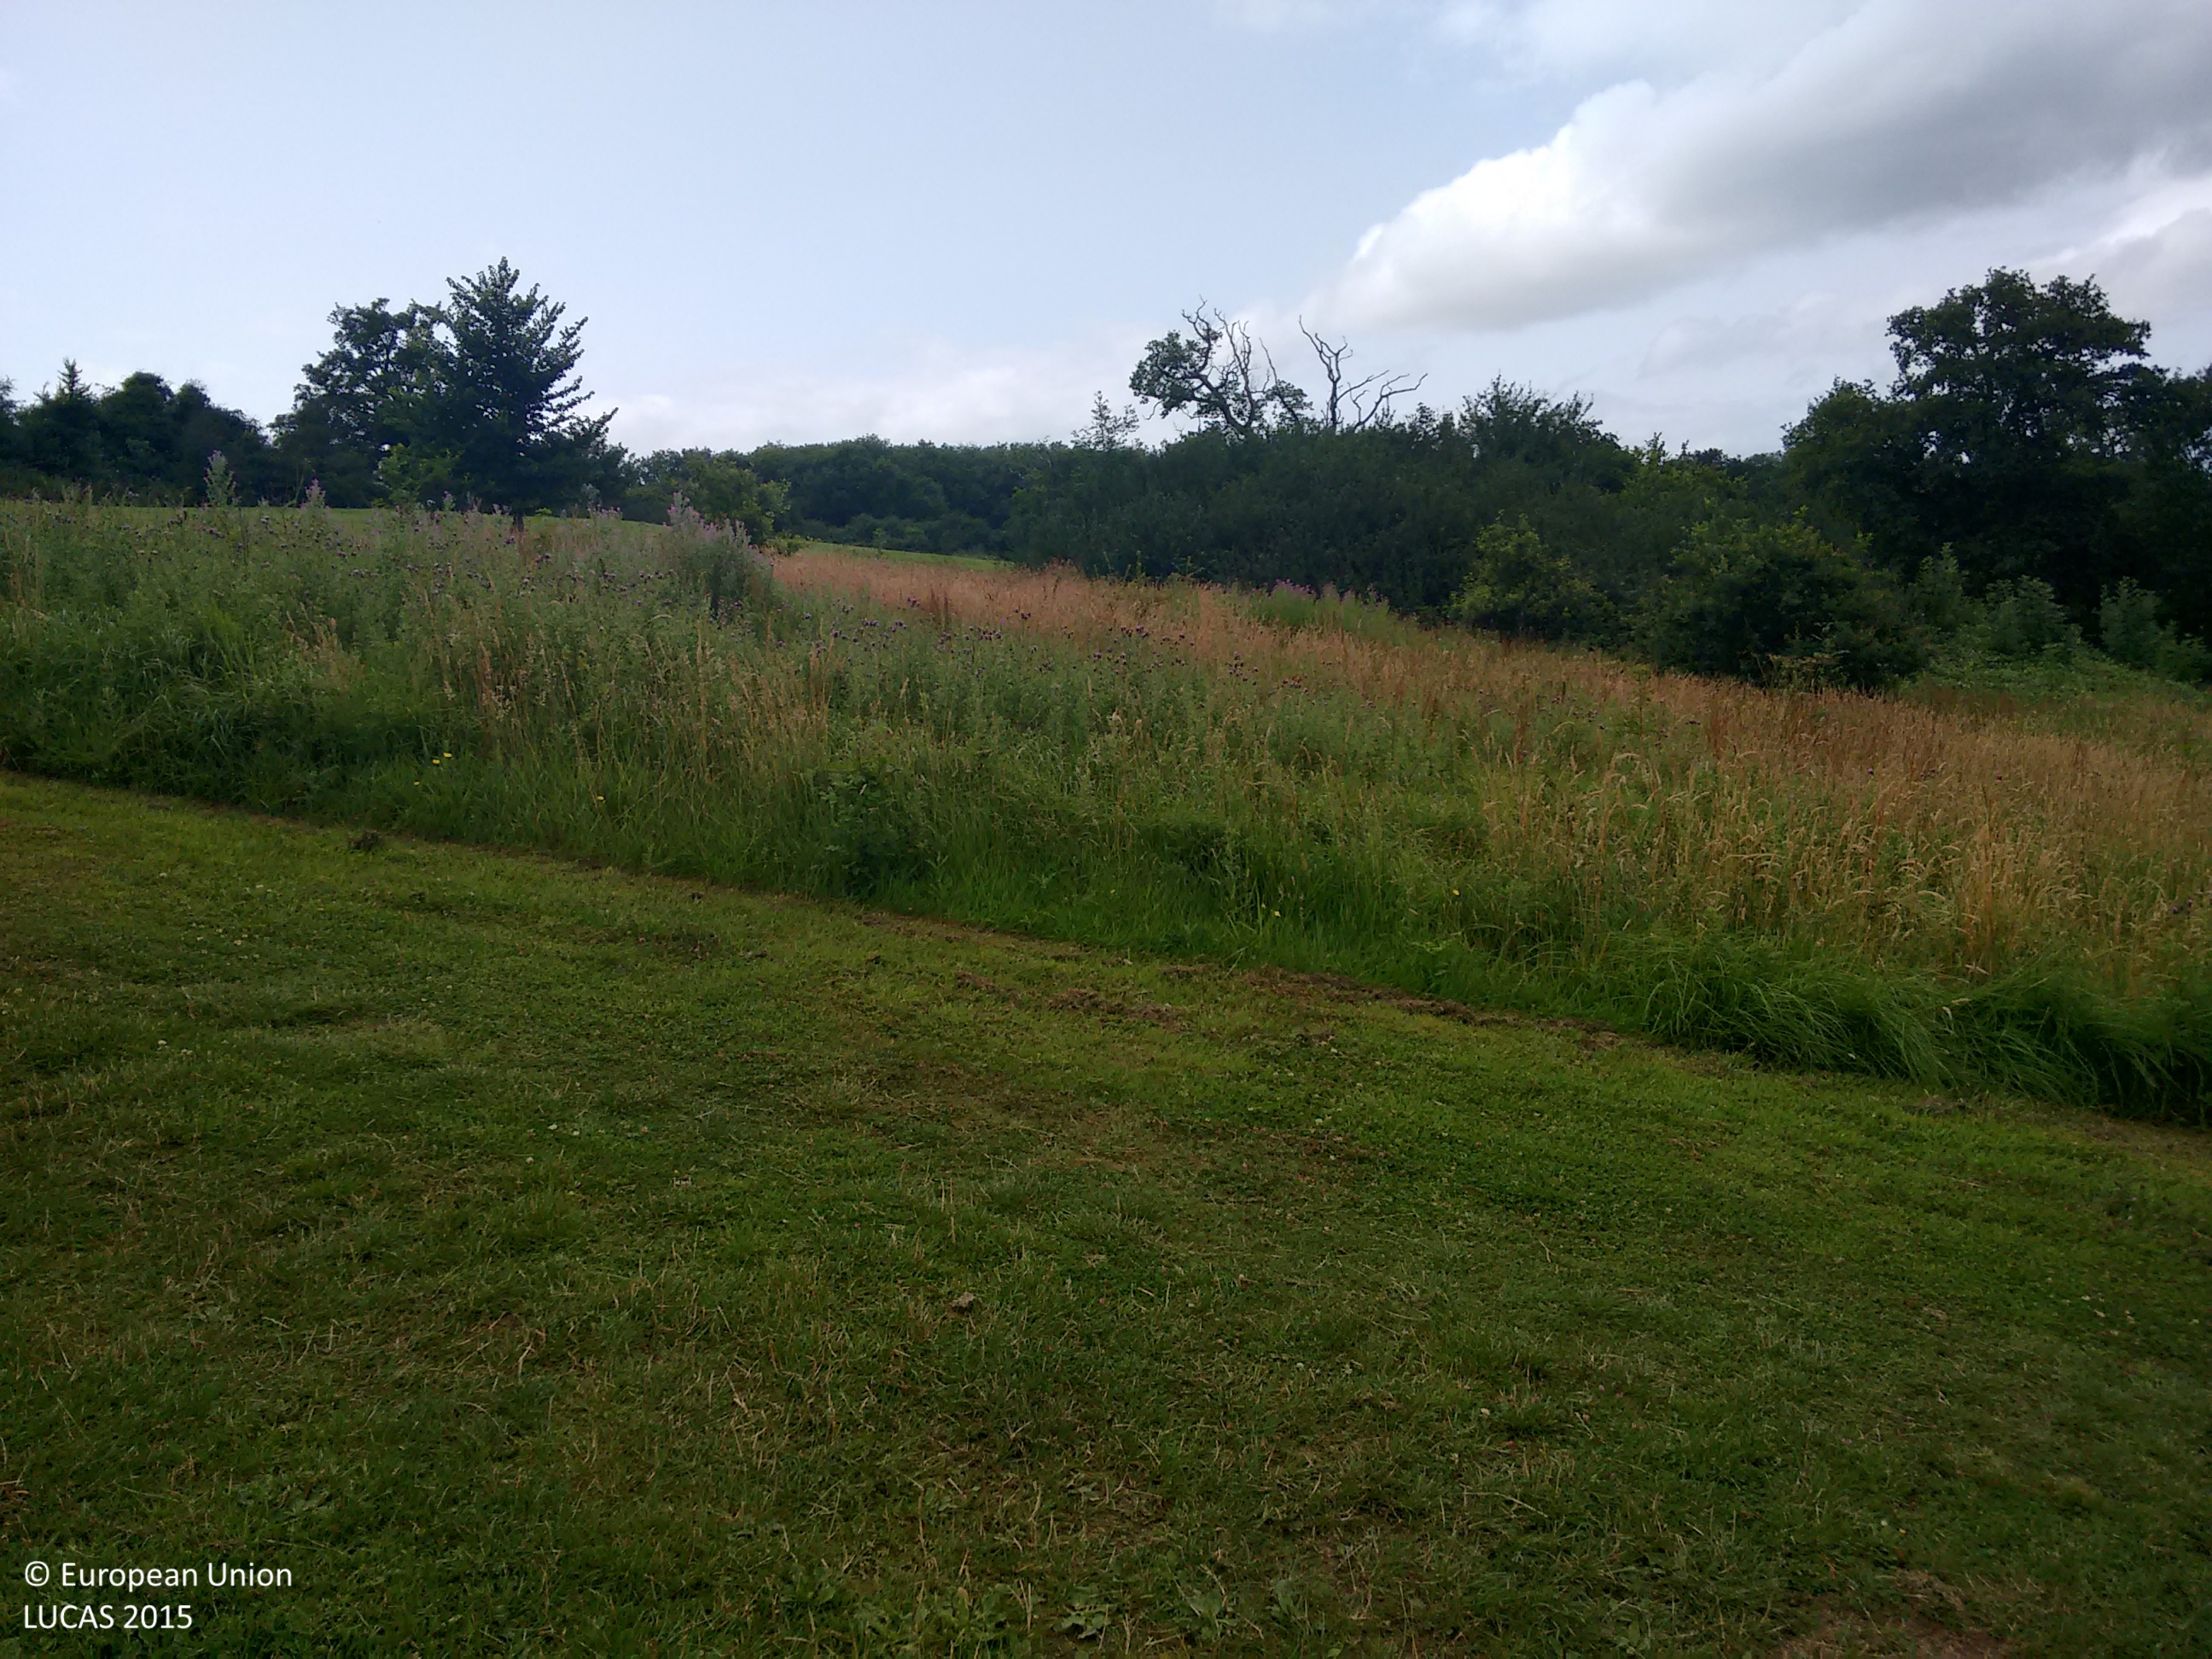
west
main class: Grassland
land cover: Grassland without tree/shrub cover
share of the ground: > 75 %
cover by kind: herbaceous plants 100 %
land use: Sport
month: July
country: GB
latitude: 51.2918
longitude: -2.5284
